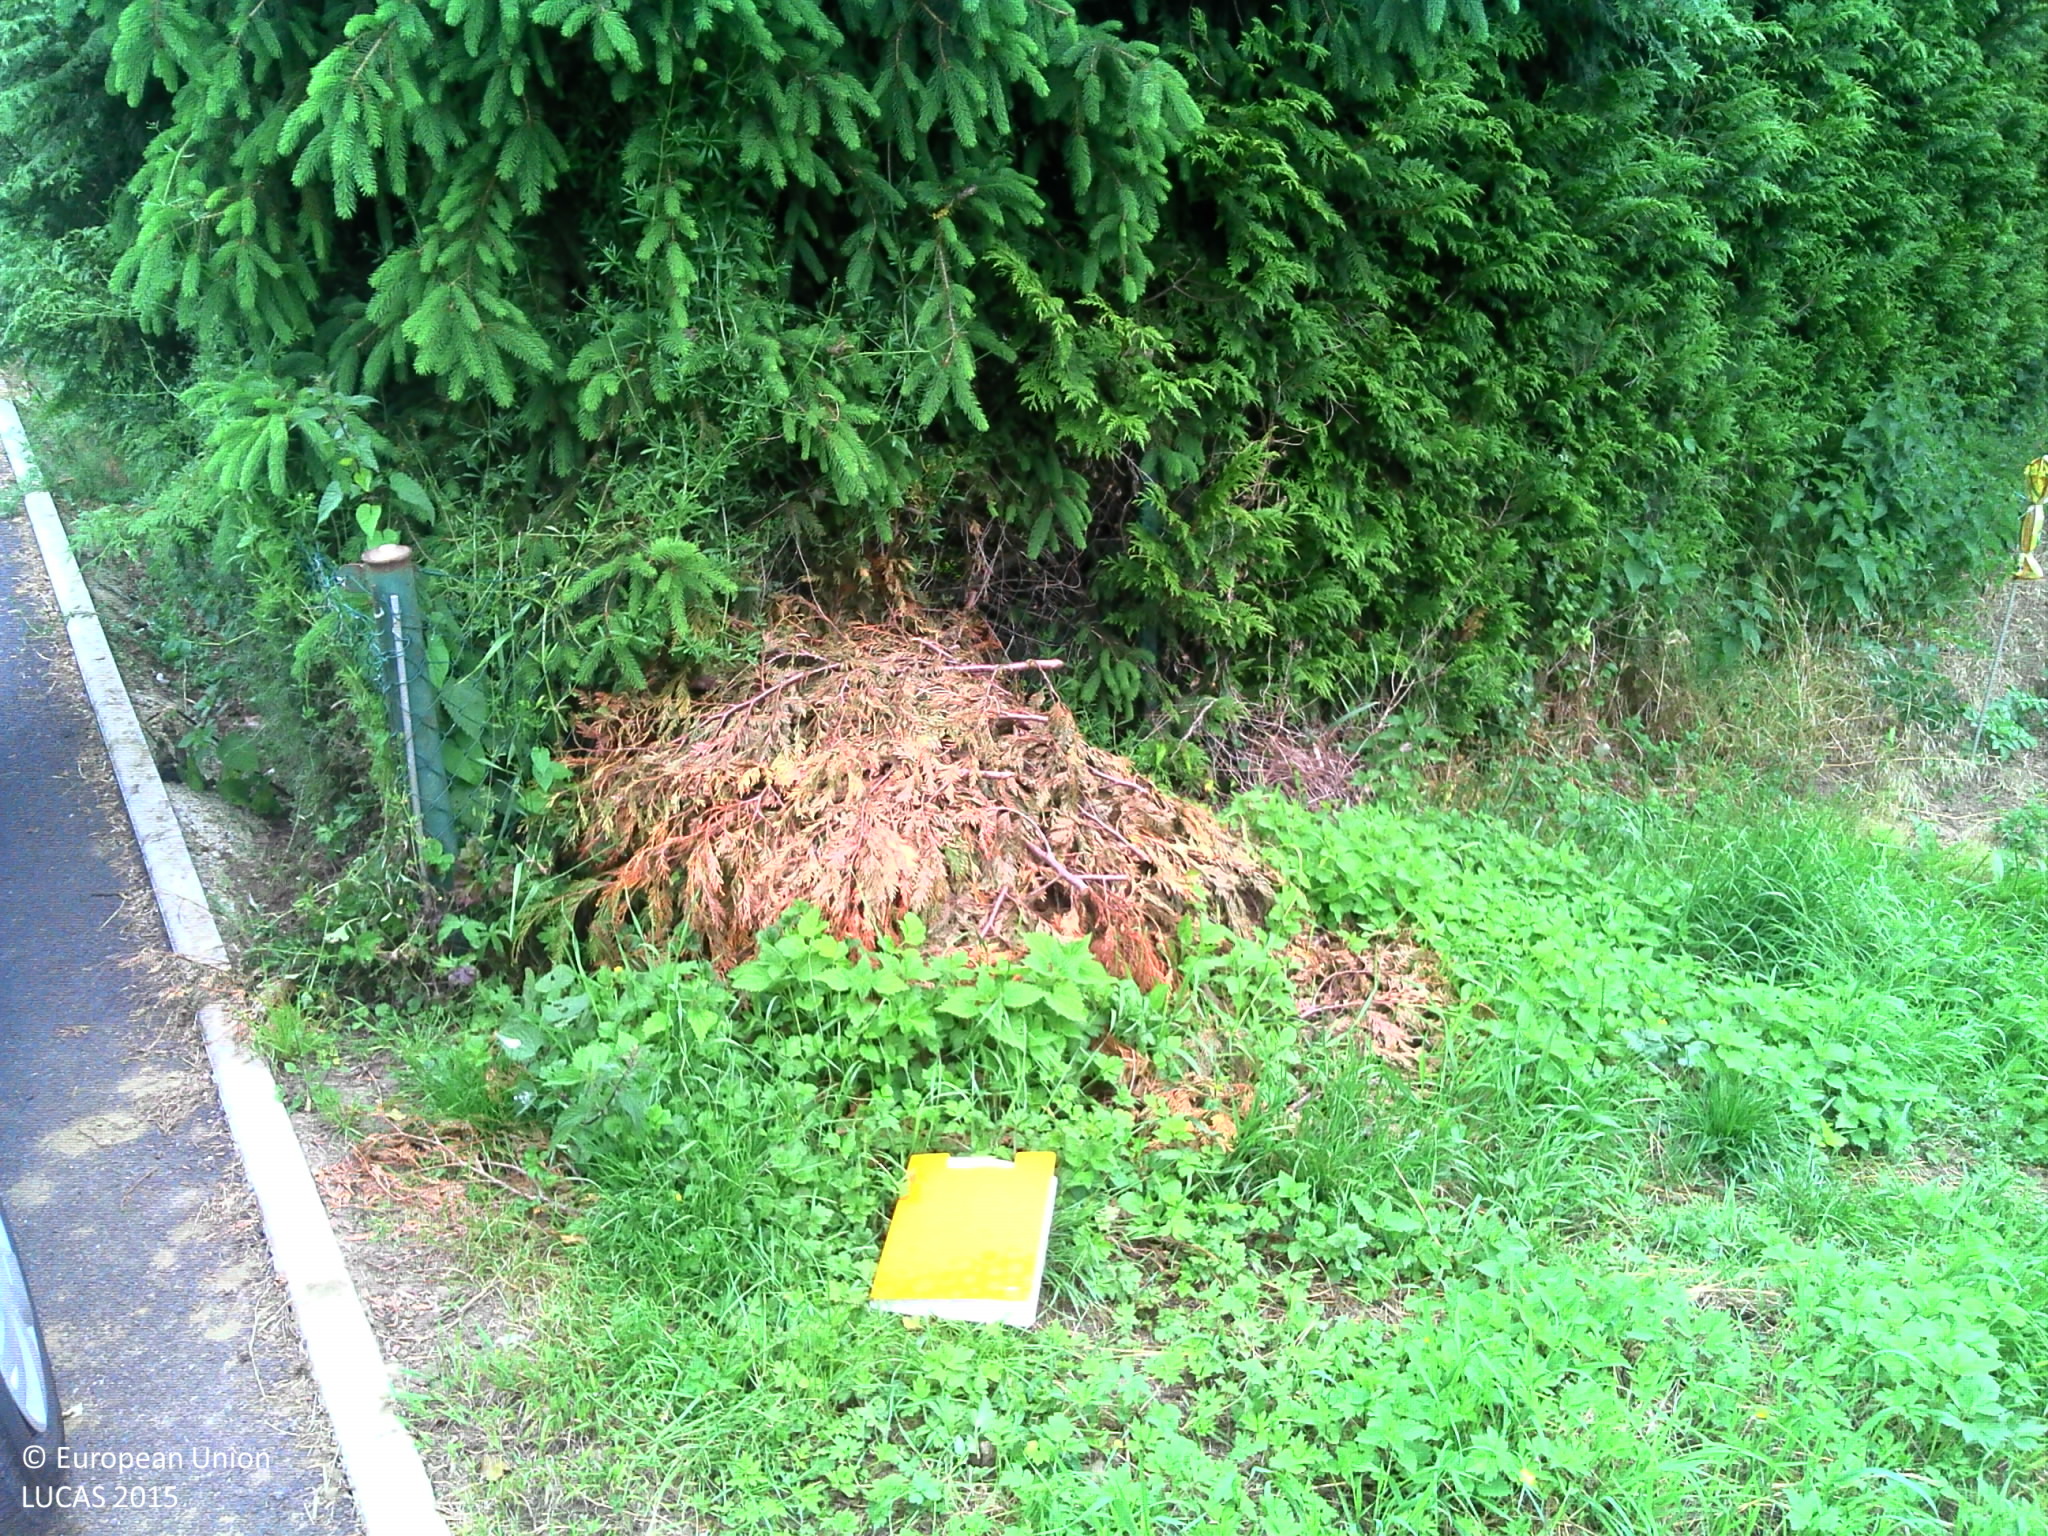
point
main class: Grassland
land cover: Grassland without tree/shrub cover
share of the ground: > 75 %
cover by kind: herbaceous plants 100 %
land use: Semi-natural and natural areas not in use
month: June
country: FR
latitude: 49.5158
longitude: 3.2651
